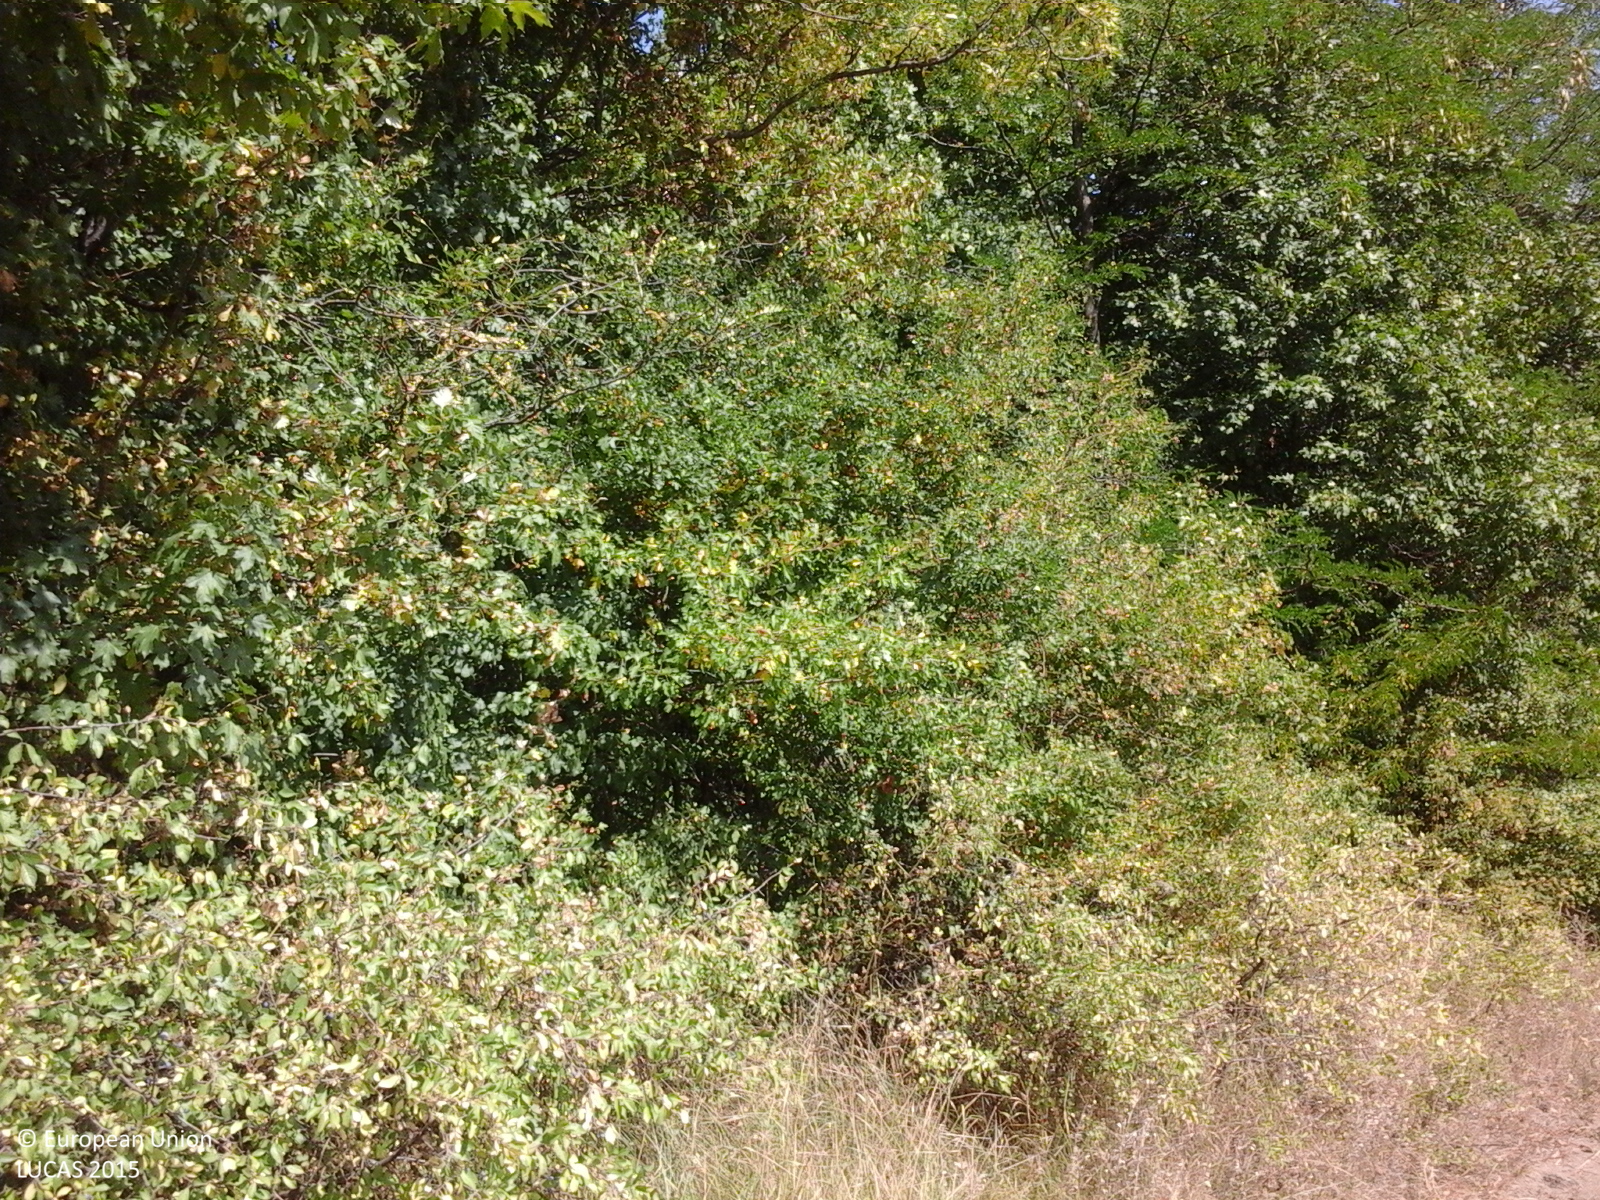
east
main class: Woodland
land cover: Broadleaved woodland
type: acidophilous oak and oak-birch forest
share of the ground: > 75 %
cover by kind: broadleaved forest trees 100 %
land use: Forestry
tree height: > 5 m
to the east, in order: Broadleaved woodland; Tracks; Grassland without tree/shrub cover
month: July
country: RO
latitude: 46.2093
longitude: 27.8905
